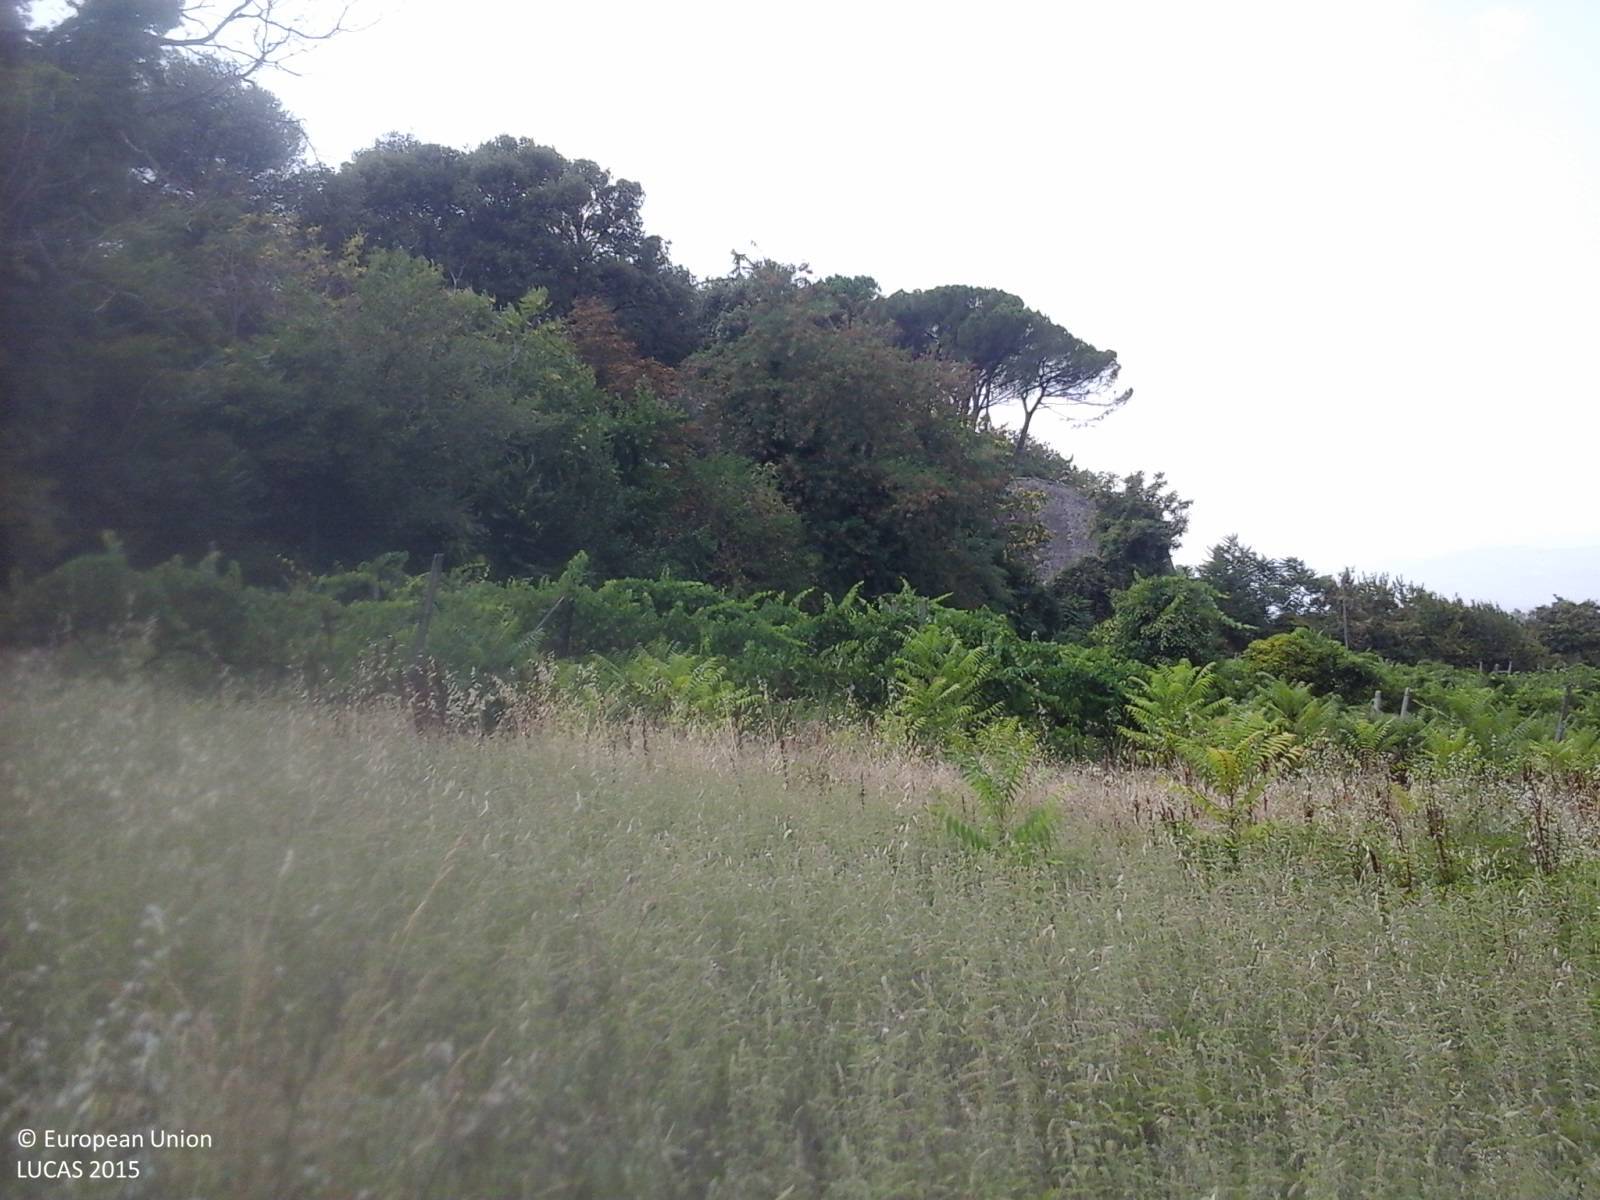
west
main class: Grassland
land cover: Spontaneously vegetated surfaces
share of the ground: > 75 %
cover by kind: herbaceous plants 100 %
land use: Fallow land
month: August
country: IT
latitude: 43.4672
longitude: 11.8860
